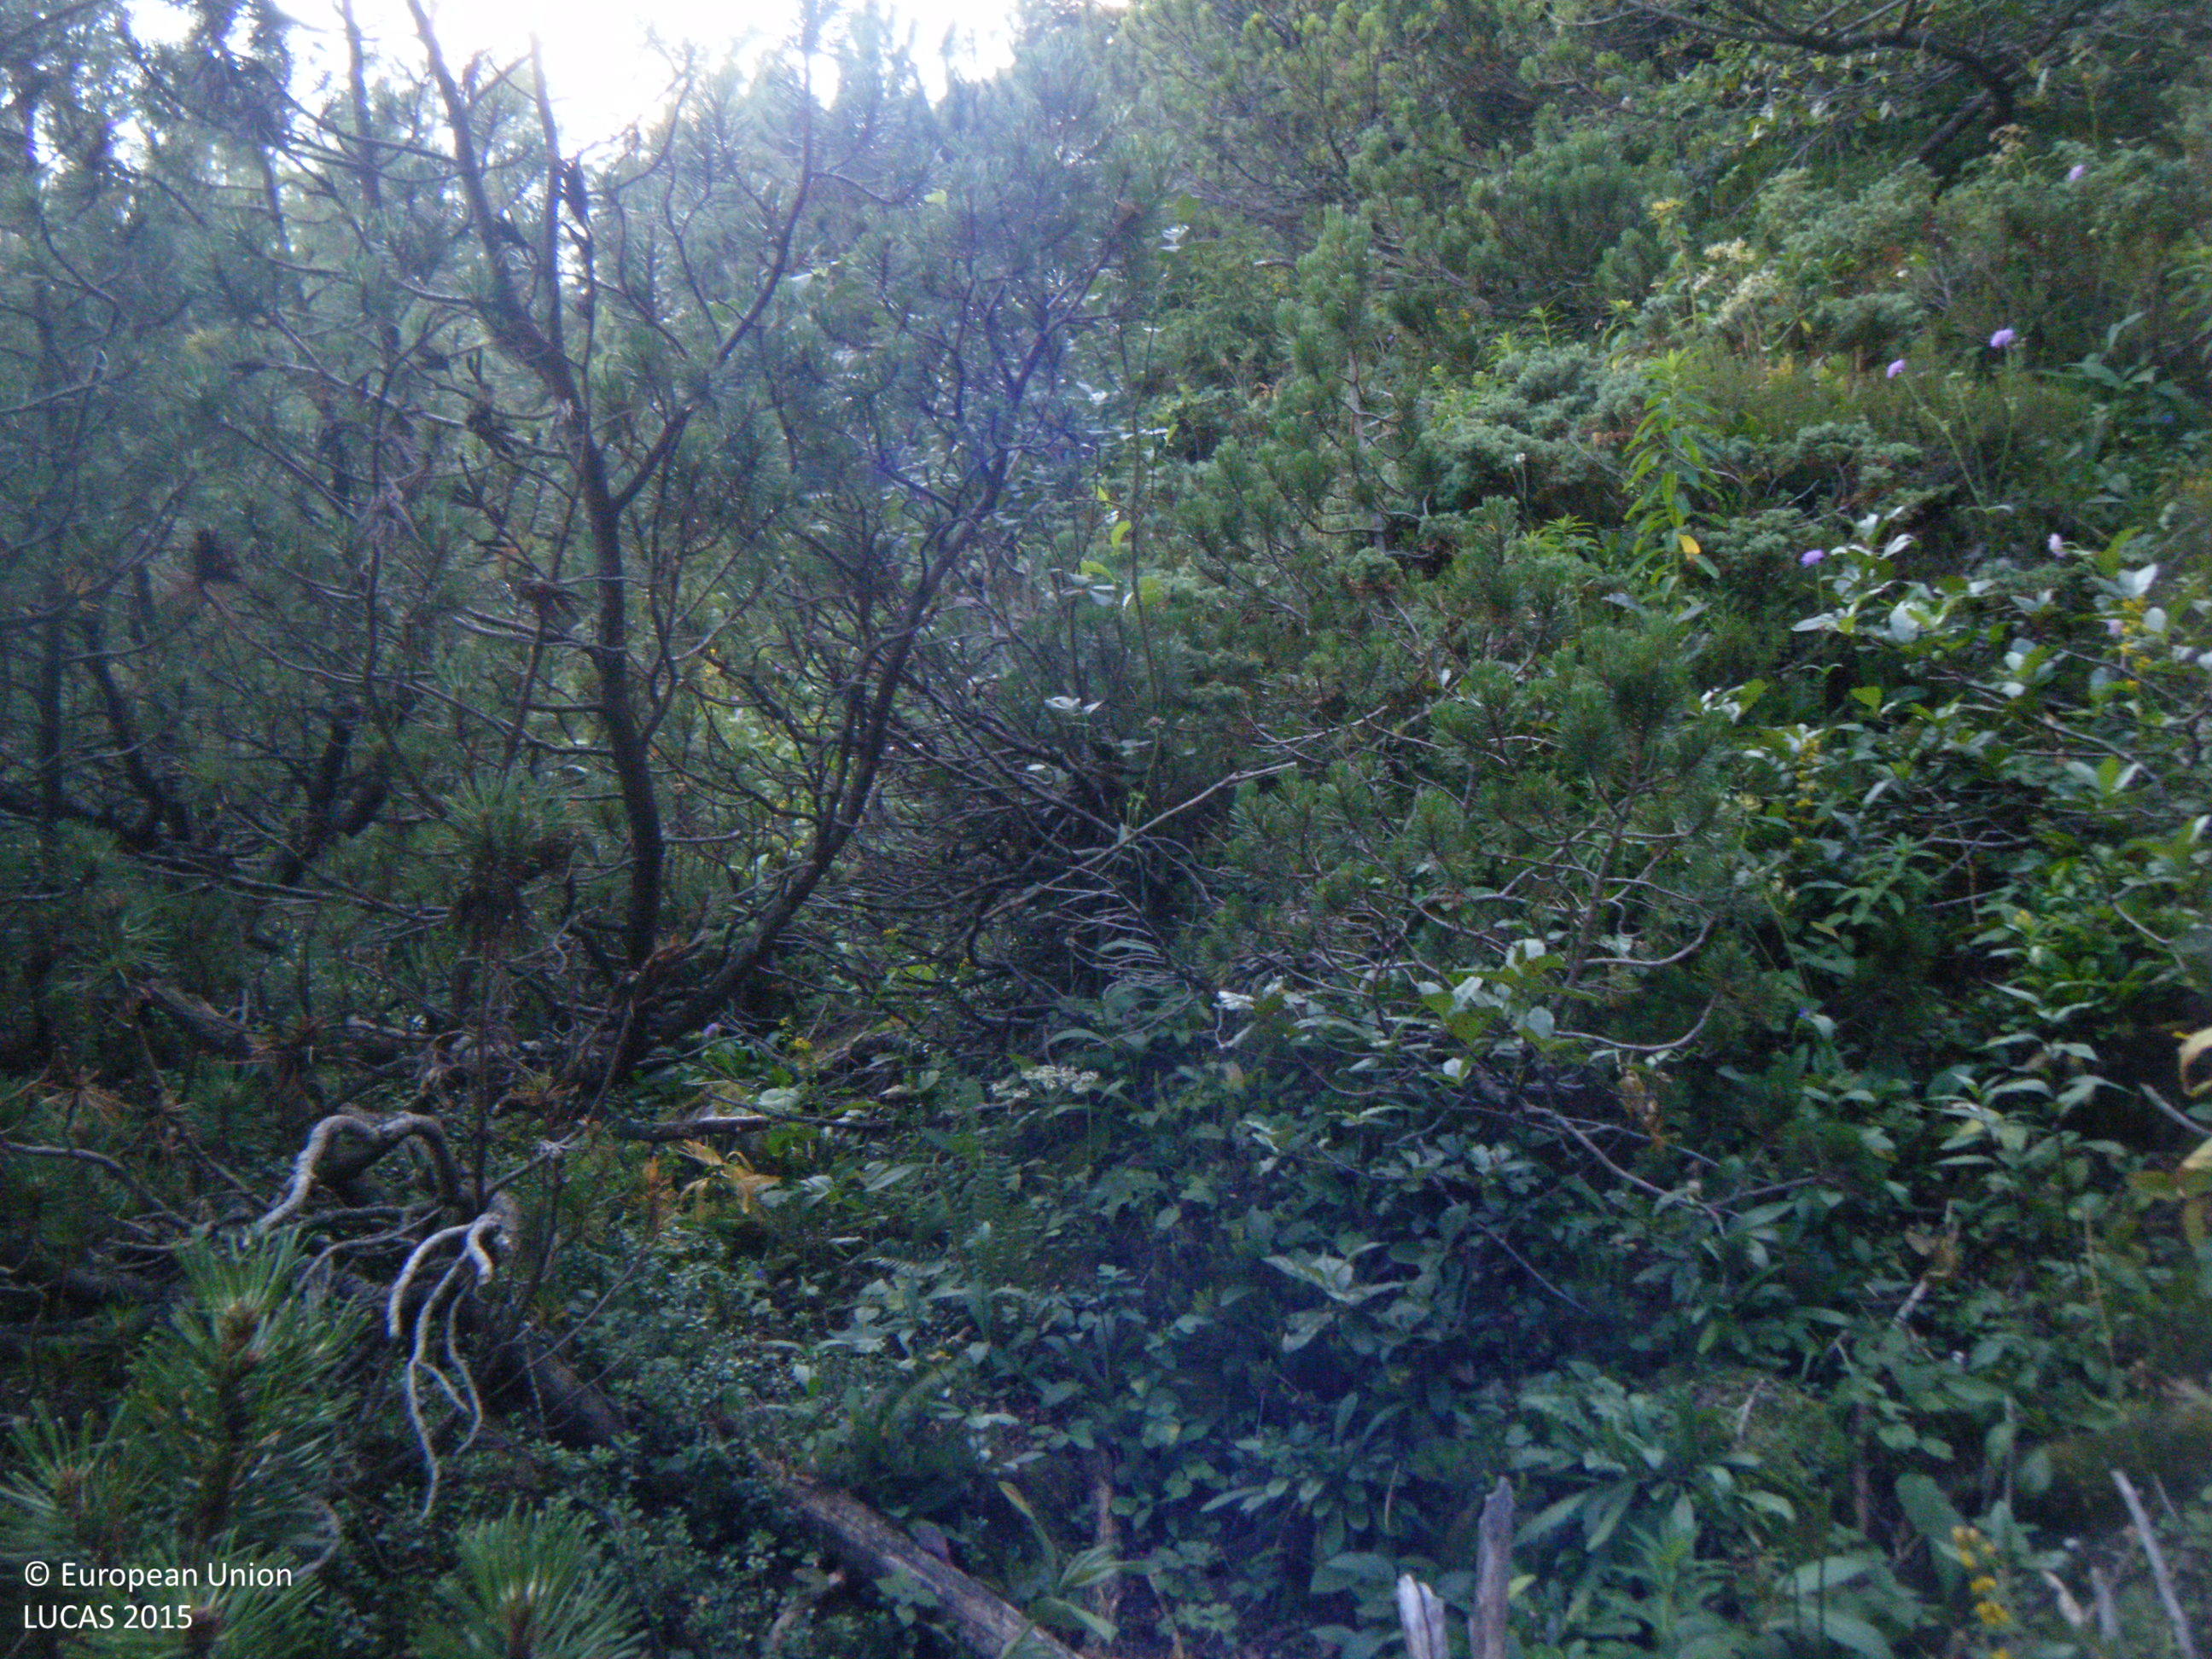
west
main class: Woodland
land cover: Spruce dominated coniferous woodland
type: alpine coniferous forest
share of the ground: 25 - 50 %
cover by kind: coniferous forest trees 45 %, shrubs 25 %, herbaceous plants 20 %, lichens and mosses 5 %, consolidated bare surface 5 %
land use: Agriculture (excluding fallow land and kitchen gardens)
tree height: > 5 m
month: August
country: AT
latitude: 47.5933
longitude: 13.9751
